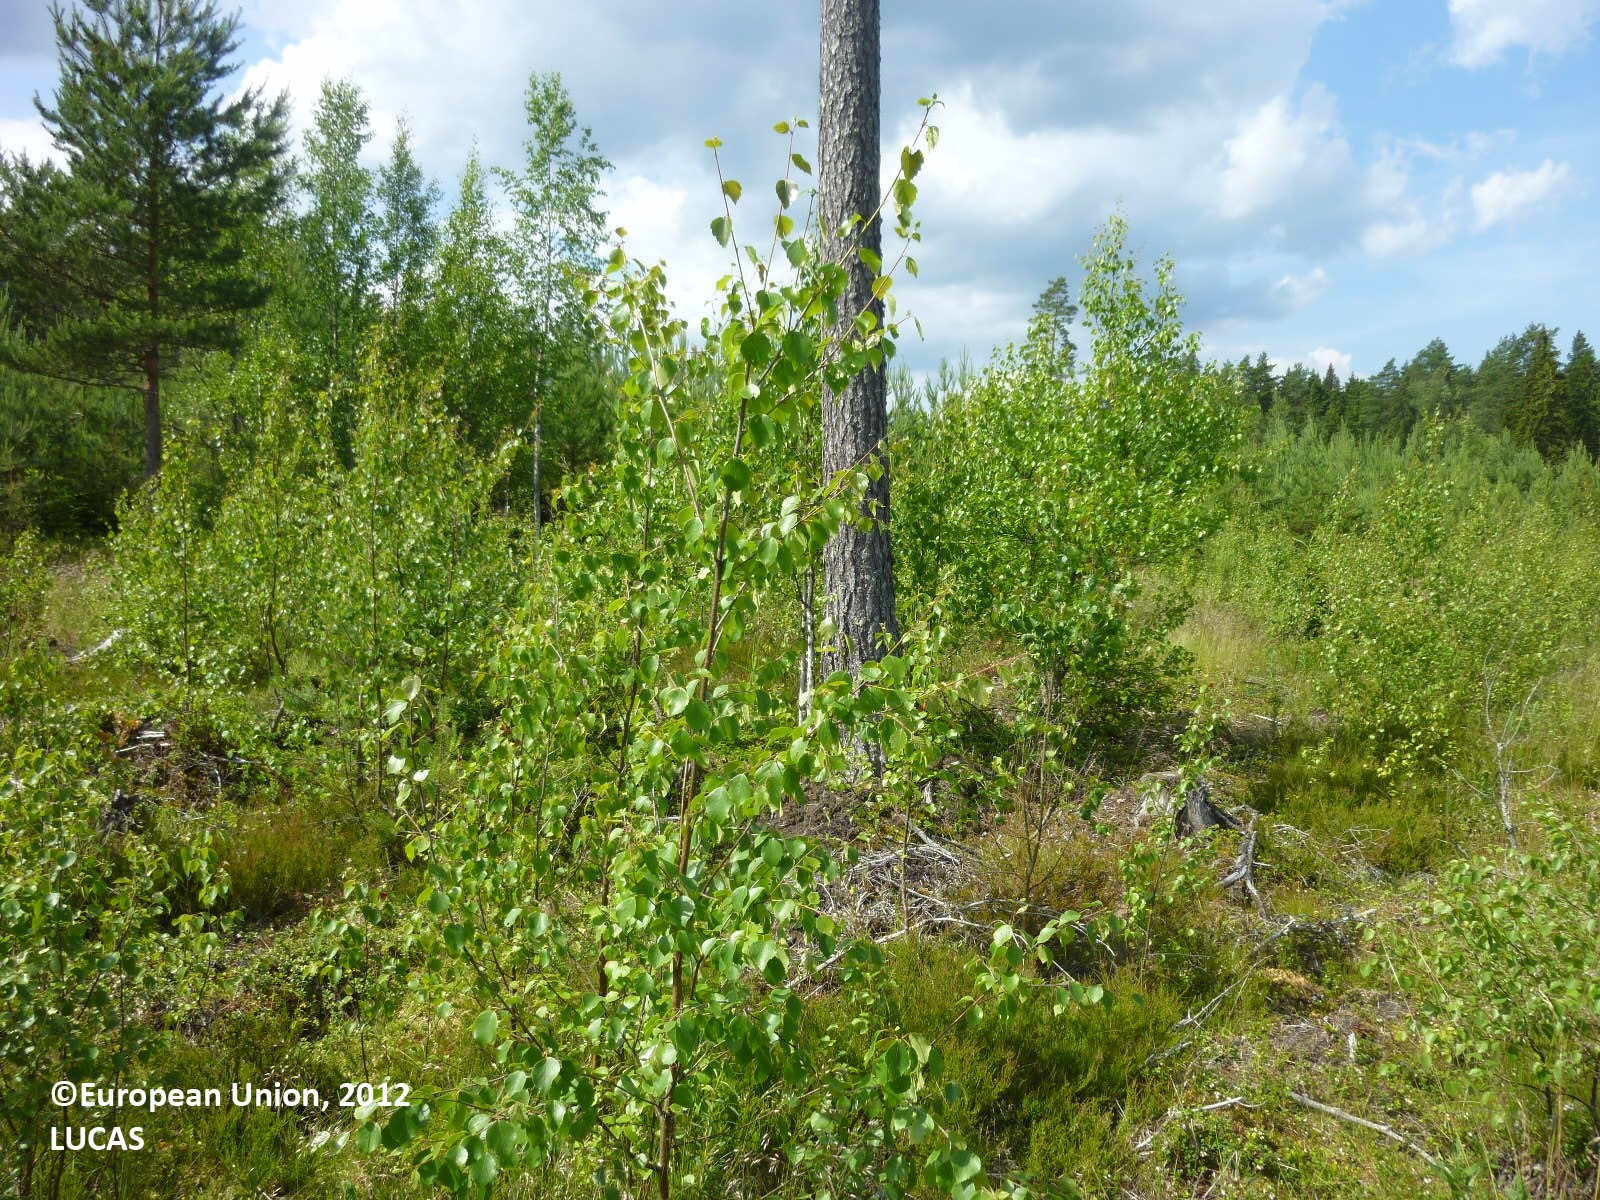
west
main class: Woodland
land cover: Other mixed woodland
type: boreal forest
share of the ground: 50 - 75 %
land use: Forestry
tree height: < 5 m
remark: Clear cut
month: July
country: FI
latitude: 61.2046
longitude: 22.3652
